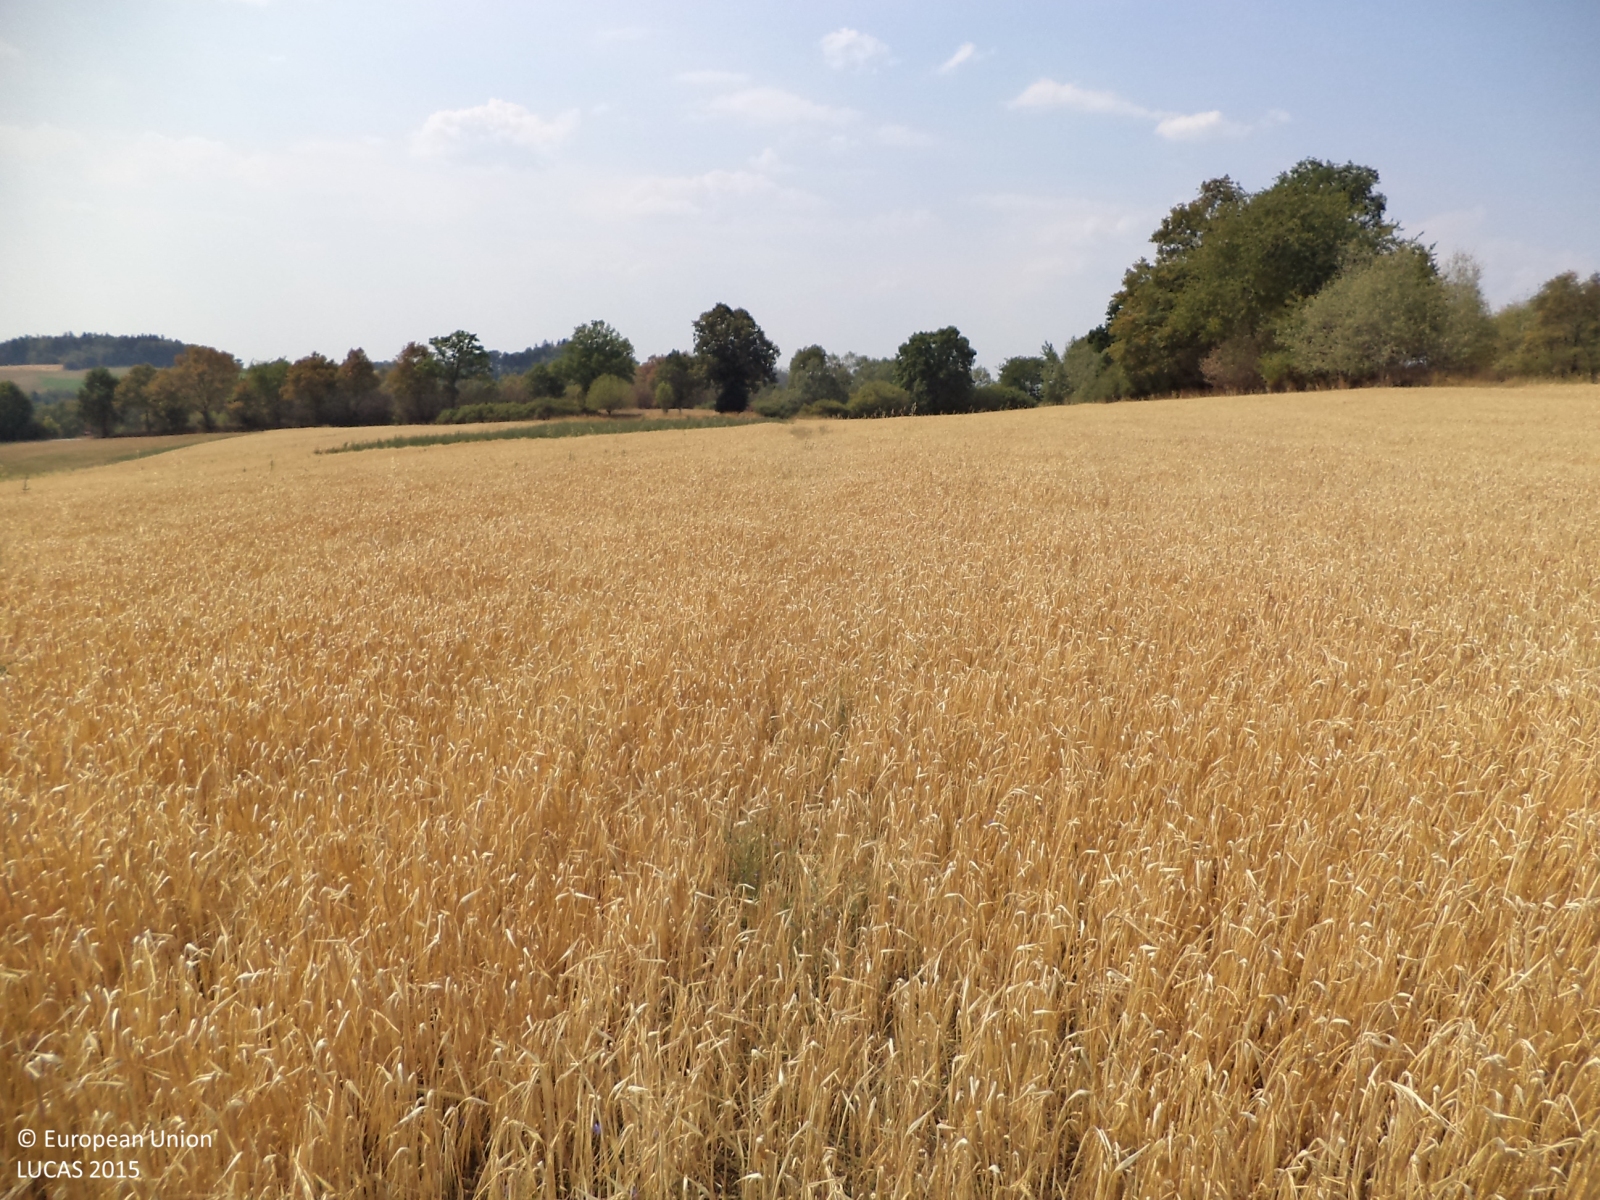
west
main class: Cropland
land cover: Barley
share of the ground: > 75 %
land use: Agriculture (excluding fallow land and kitchen gardens)
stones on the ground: < 10 %
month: August
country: CZ
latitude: 49.5037
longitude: 14.4340
